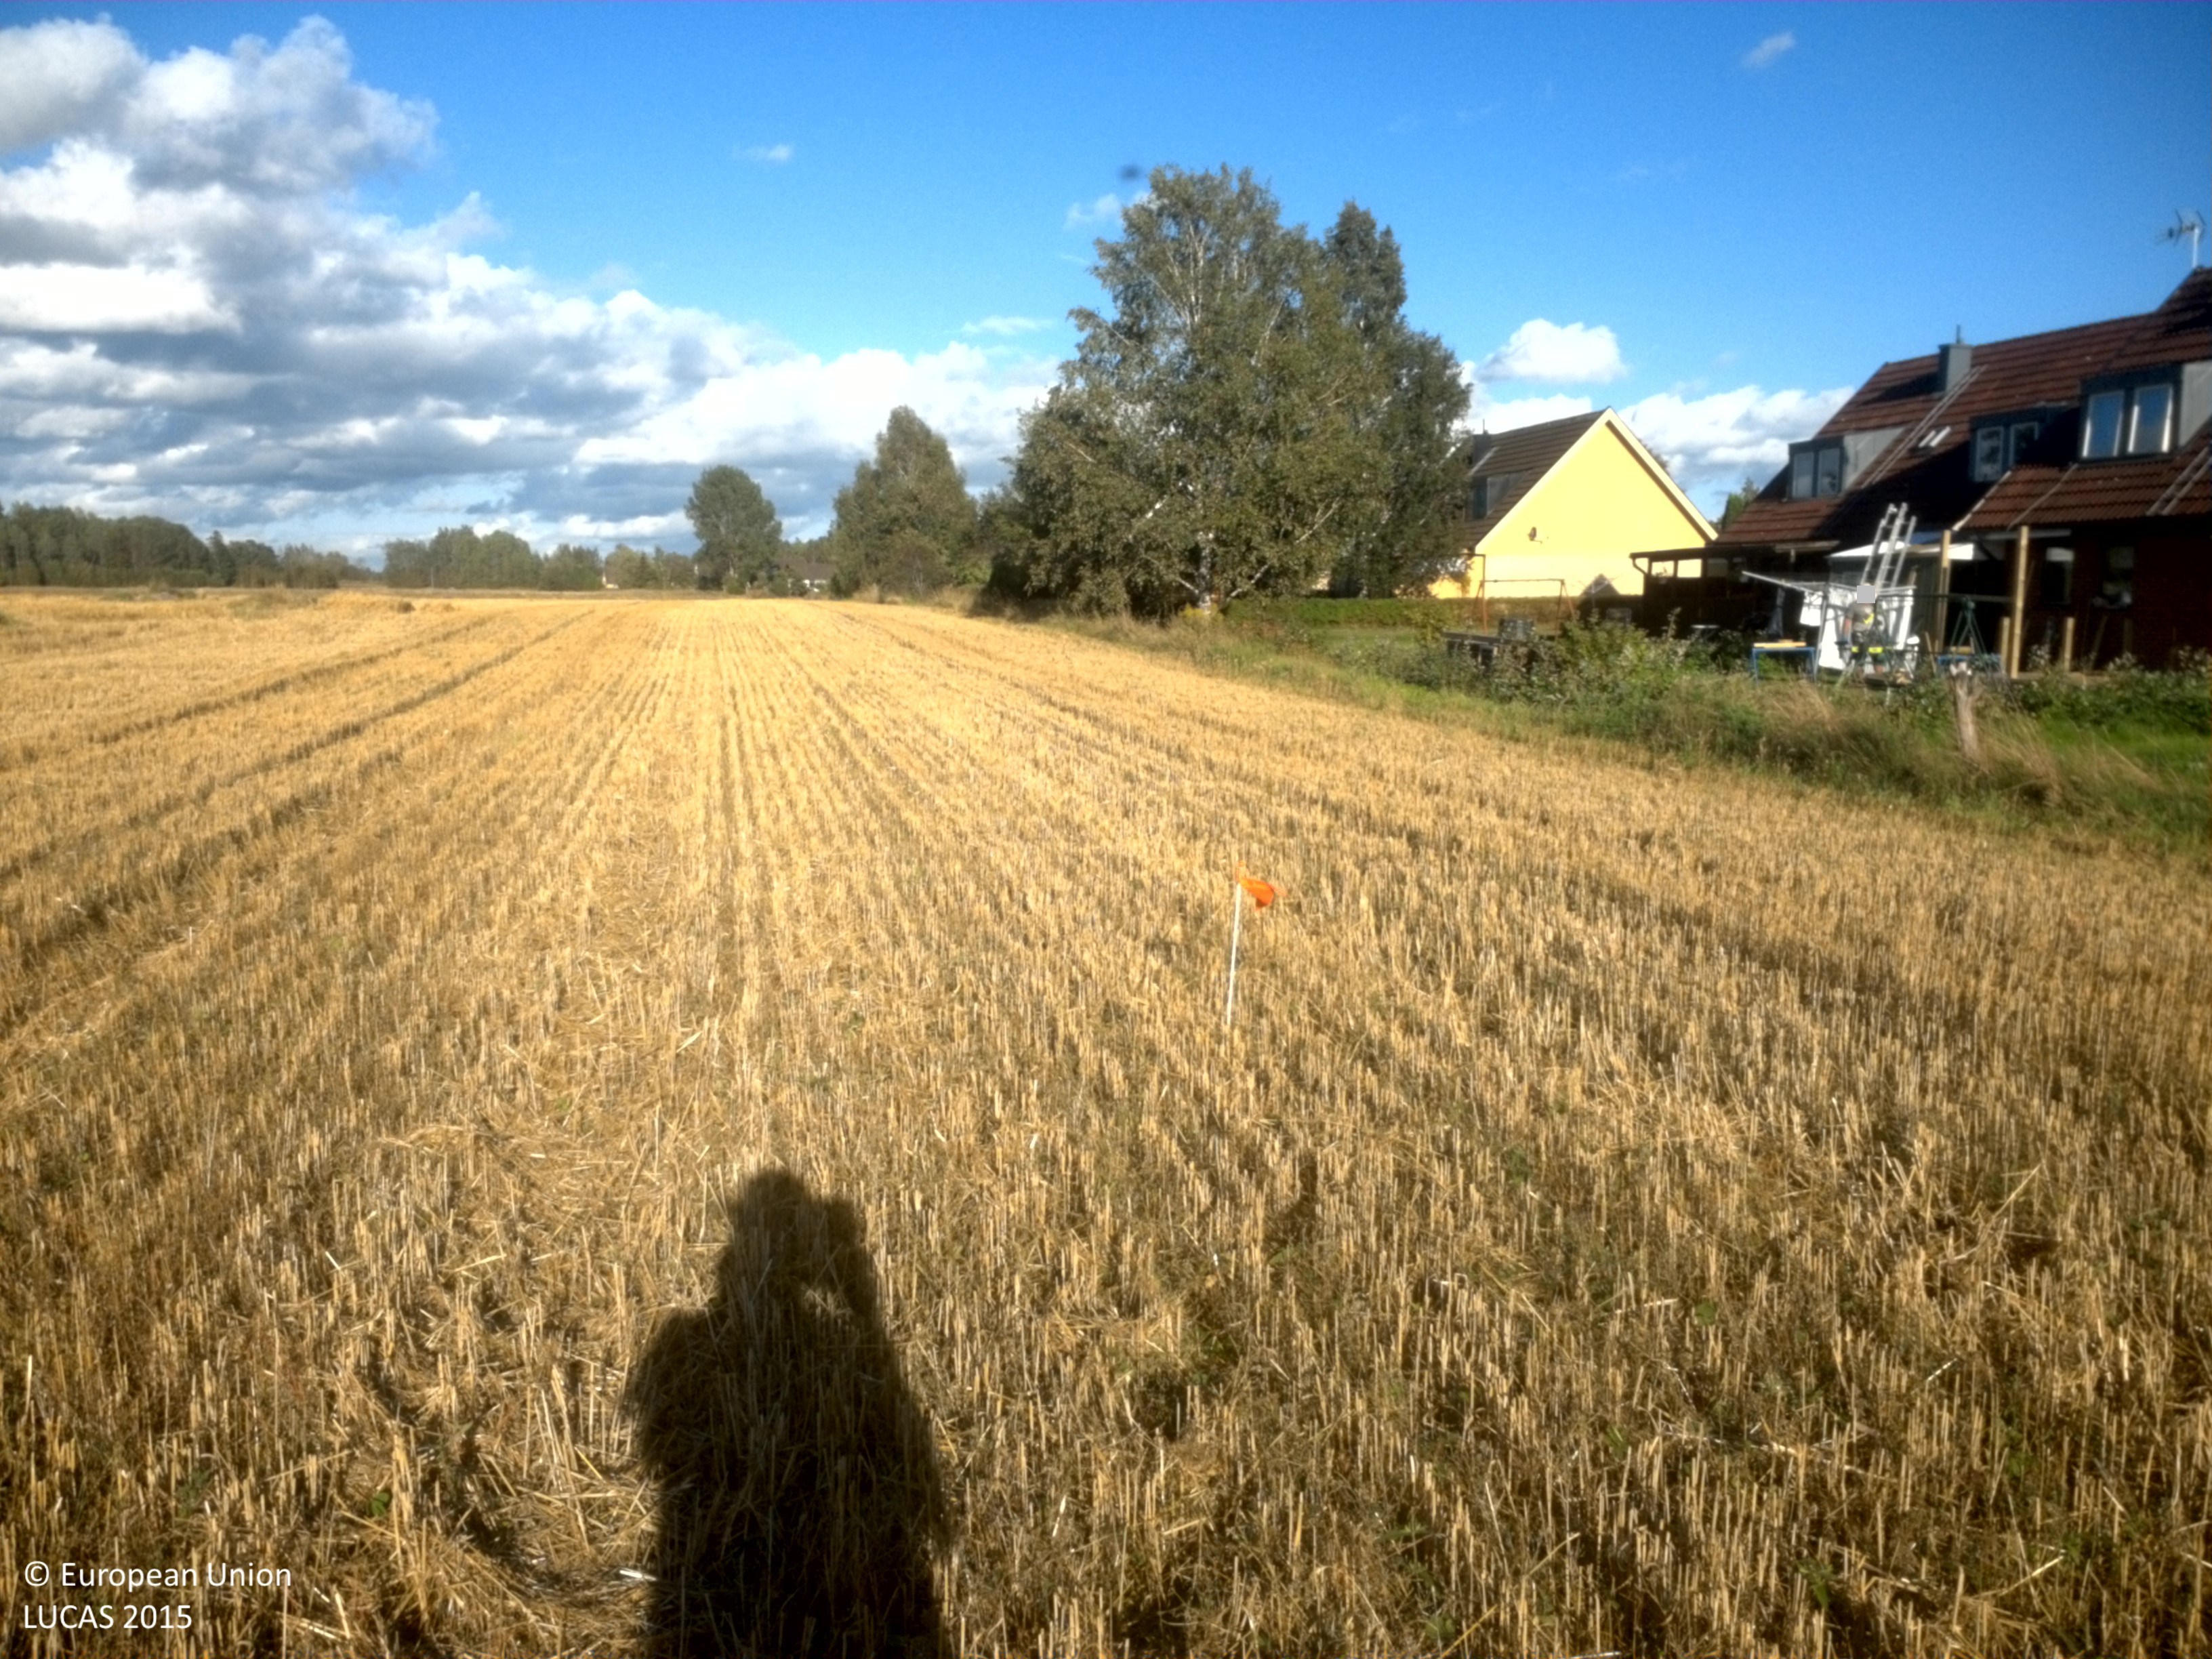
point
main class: Cropland
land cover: Common wheat
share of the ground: > 75 %
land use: Agriculture (excluding fallow land and kitchen gardens)
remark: Harvested field
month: August
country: SE
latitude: 59.4386
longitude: 15.5808
